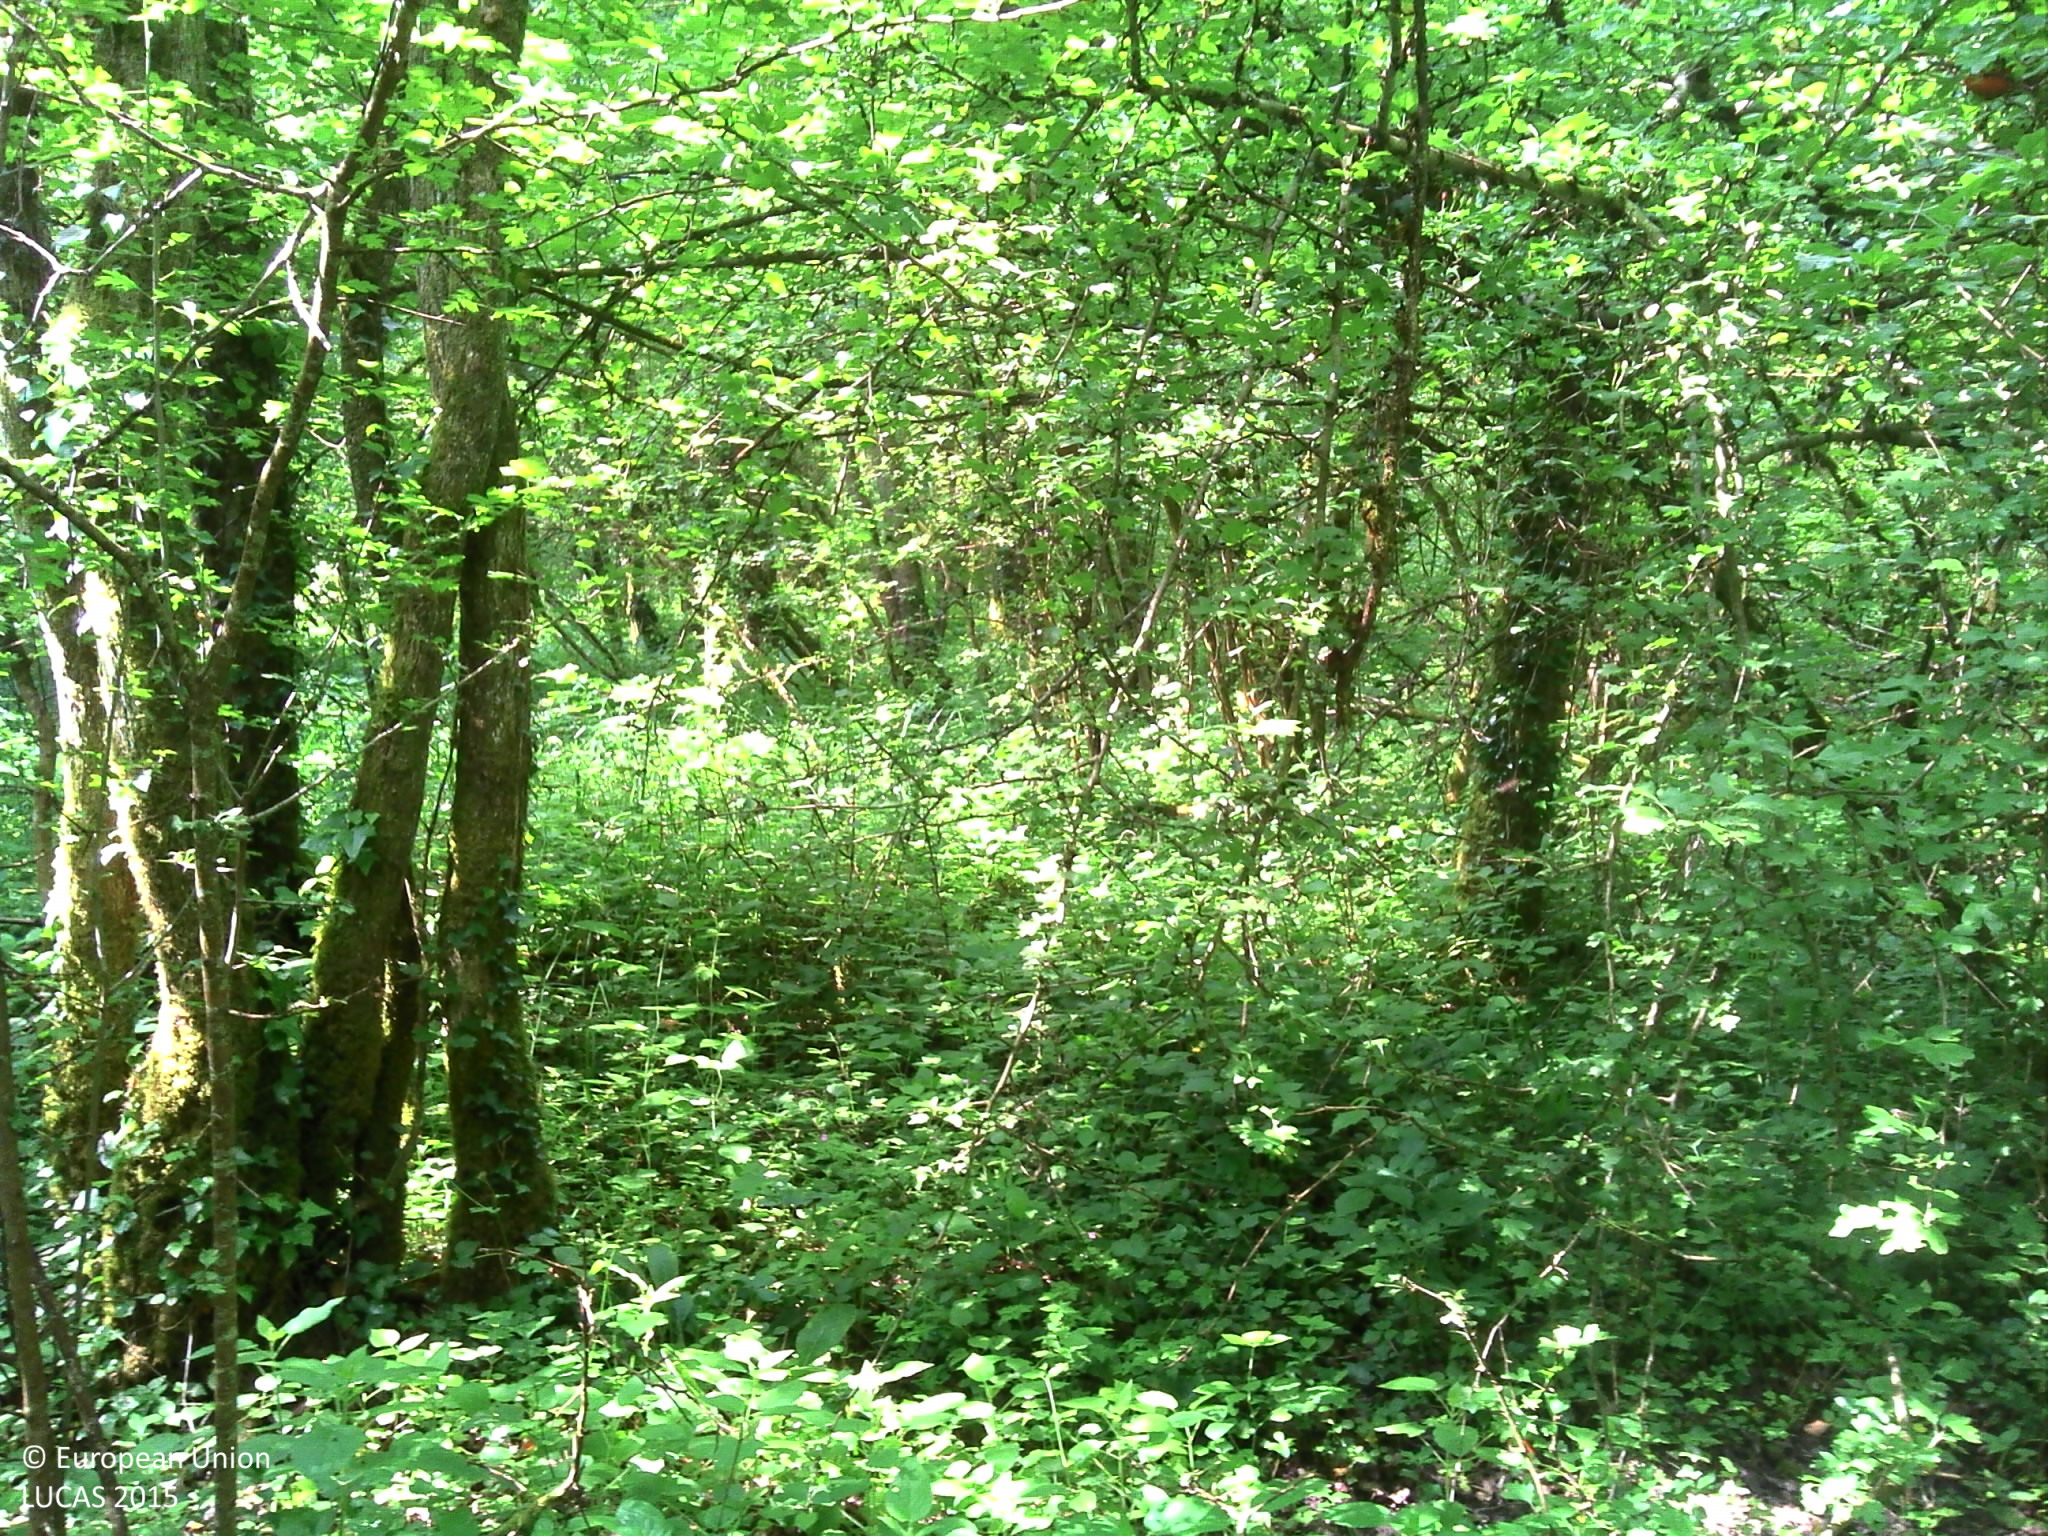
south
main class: Woodland
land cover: Broadleaved woodland
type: beech forest
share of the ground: > 75 %
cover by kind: broadleaved forest trees 90 %, herbaceous plants 10 %
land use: Forestry
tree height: > 5 m
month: June
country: FR
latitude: 47.9045
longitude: 6.1614
